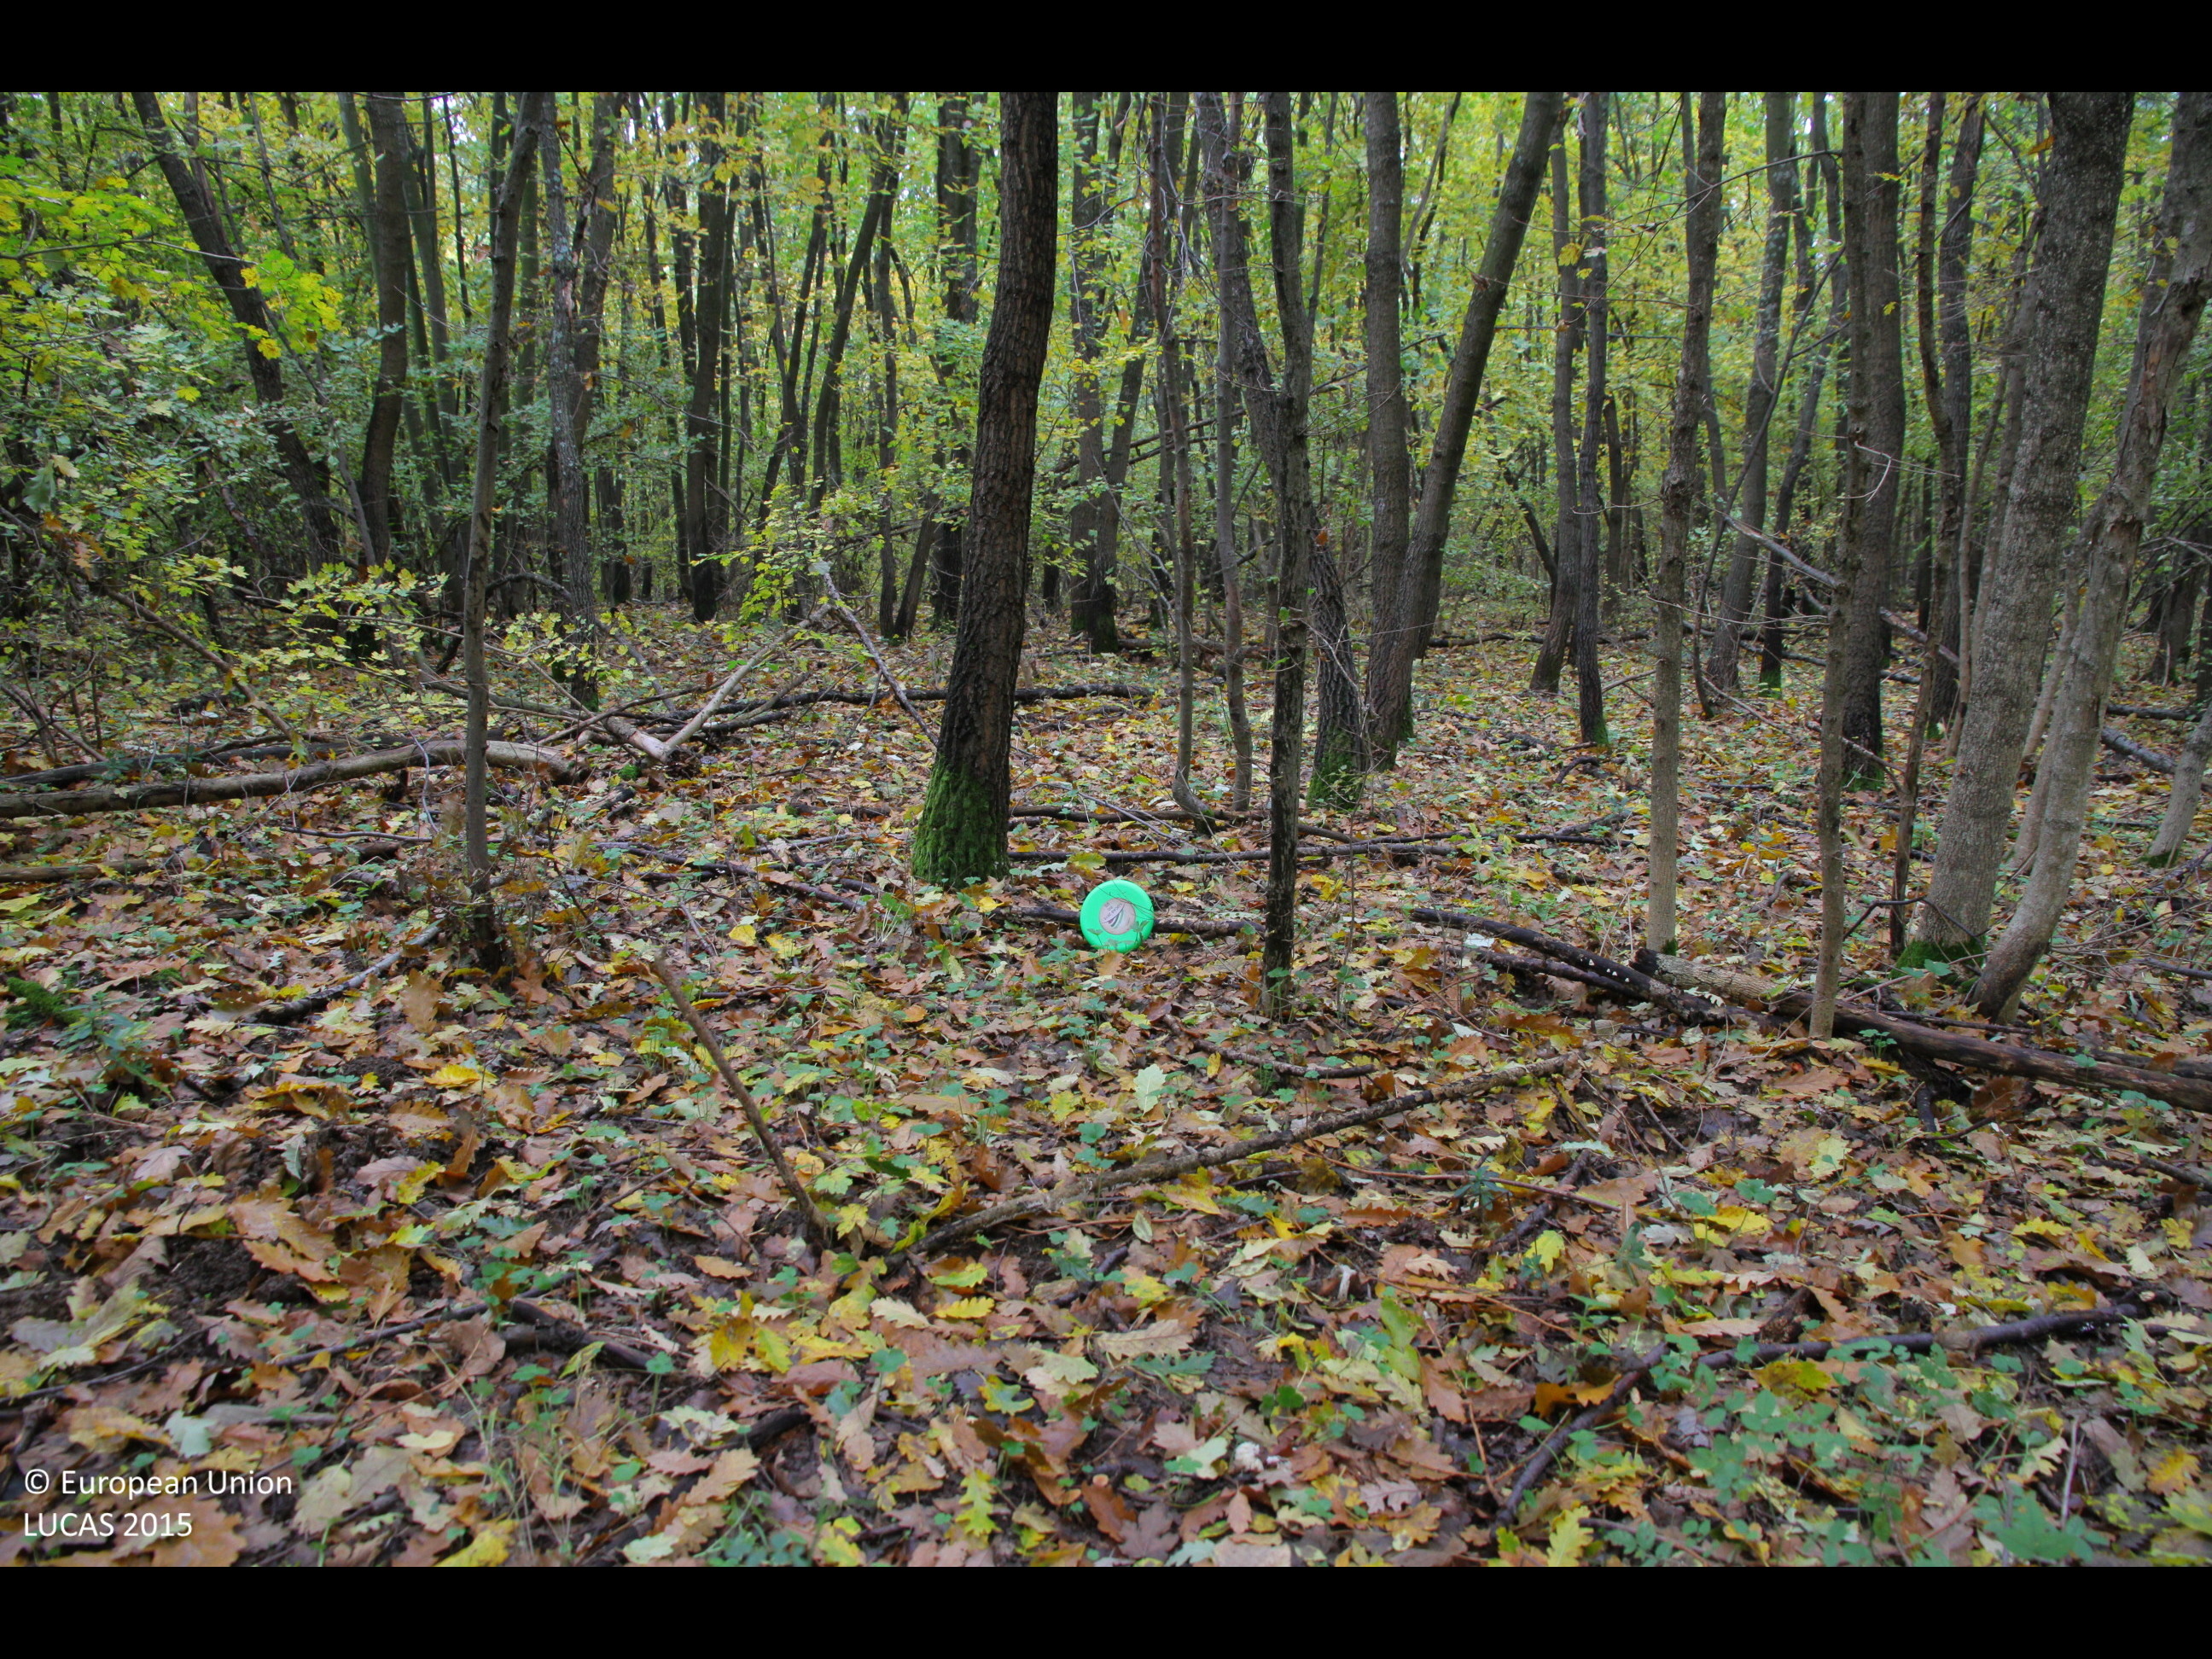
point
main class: Woodland
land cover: Broadleaved woodland
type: mesophytic deciduous forest
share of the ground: > 75 %
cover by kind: broadleaved forest trees 100 %
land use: Forestry
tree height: > 5 m
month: October
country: BG
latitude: 43.5164
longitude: 26.8260
